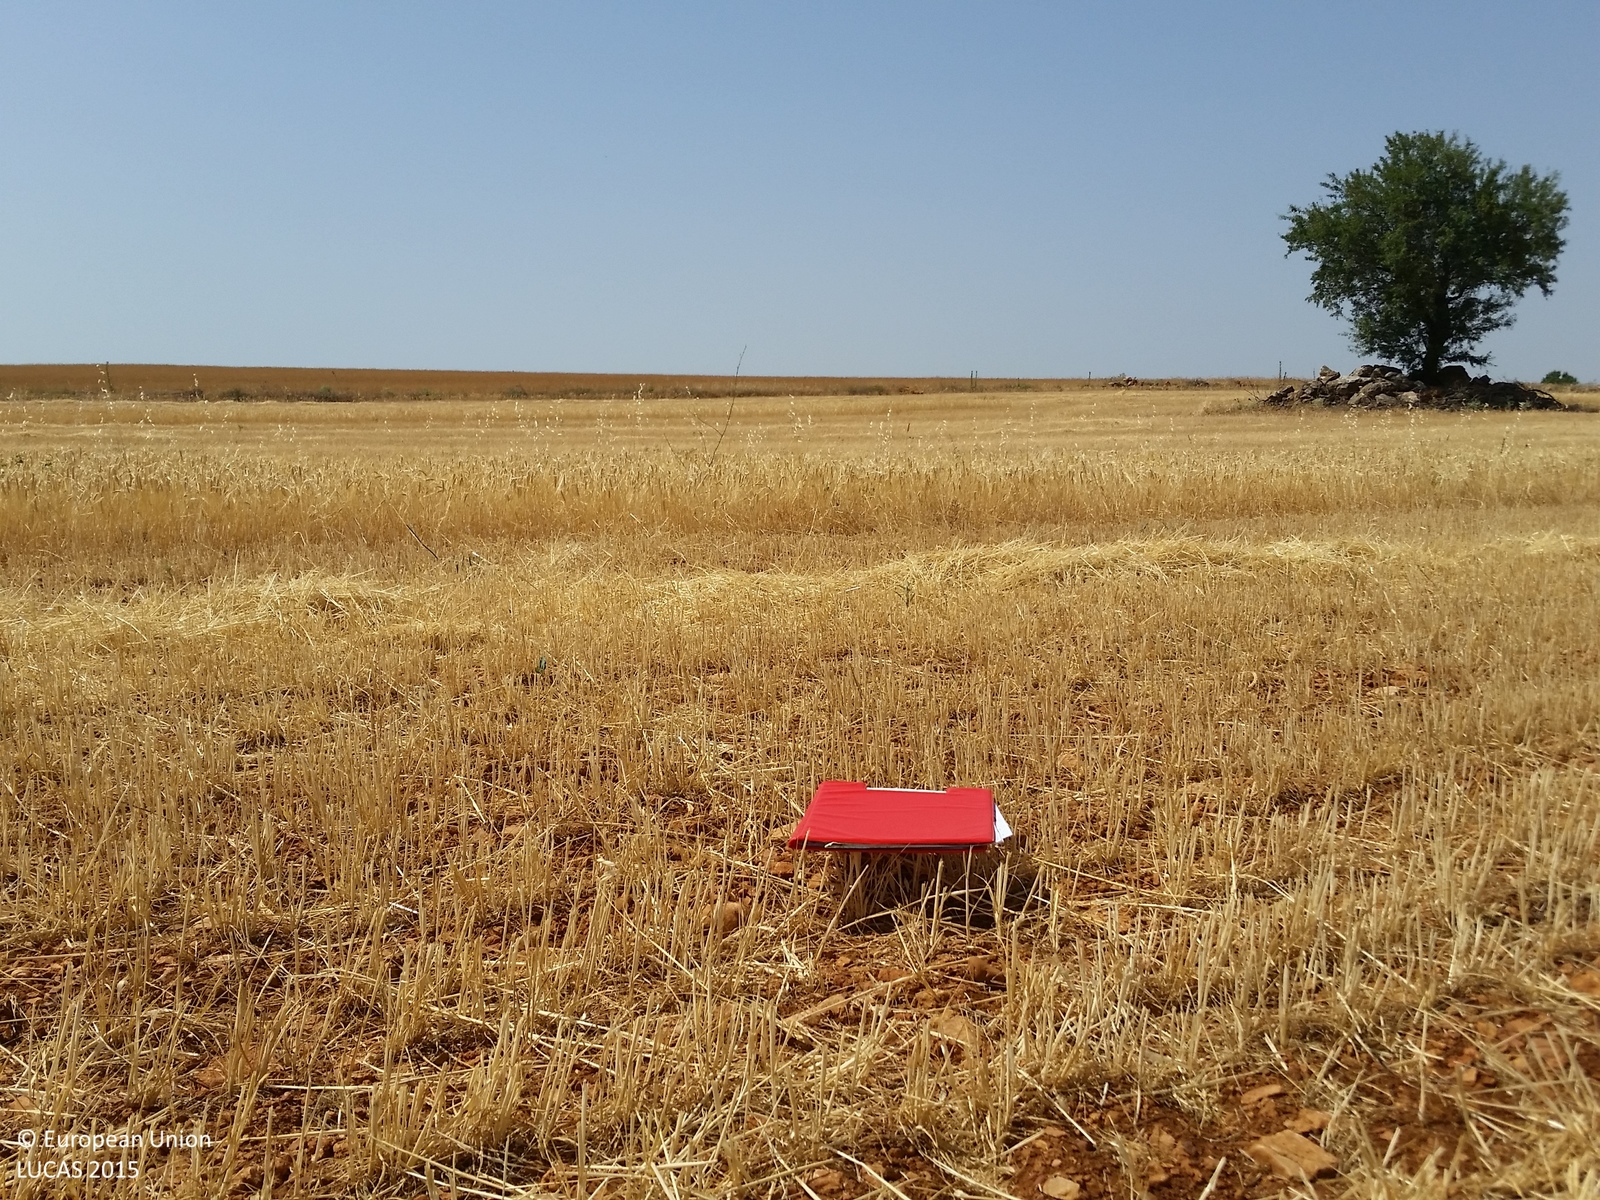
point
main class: Cropland
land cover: Barley
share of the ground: < 10 %
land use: Agriculture (excluding fallow land and kitchen gardens)
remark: Harvested field
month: June
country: ES
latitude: 38.8301
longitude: -2.5947
